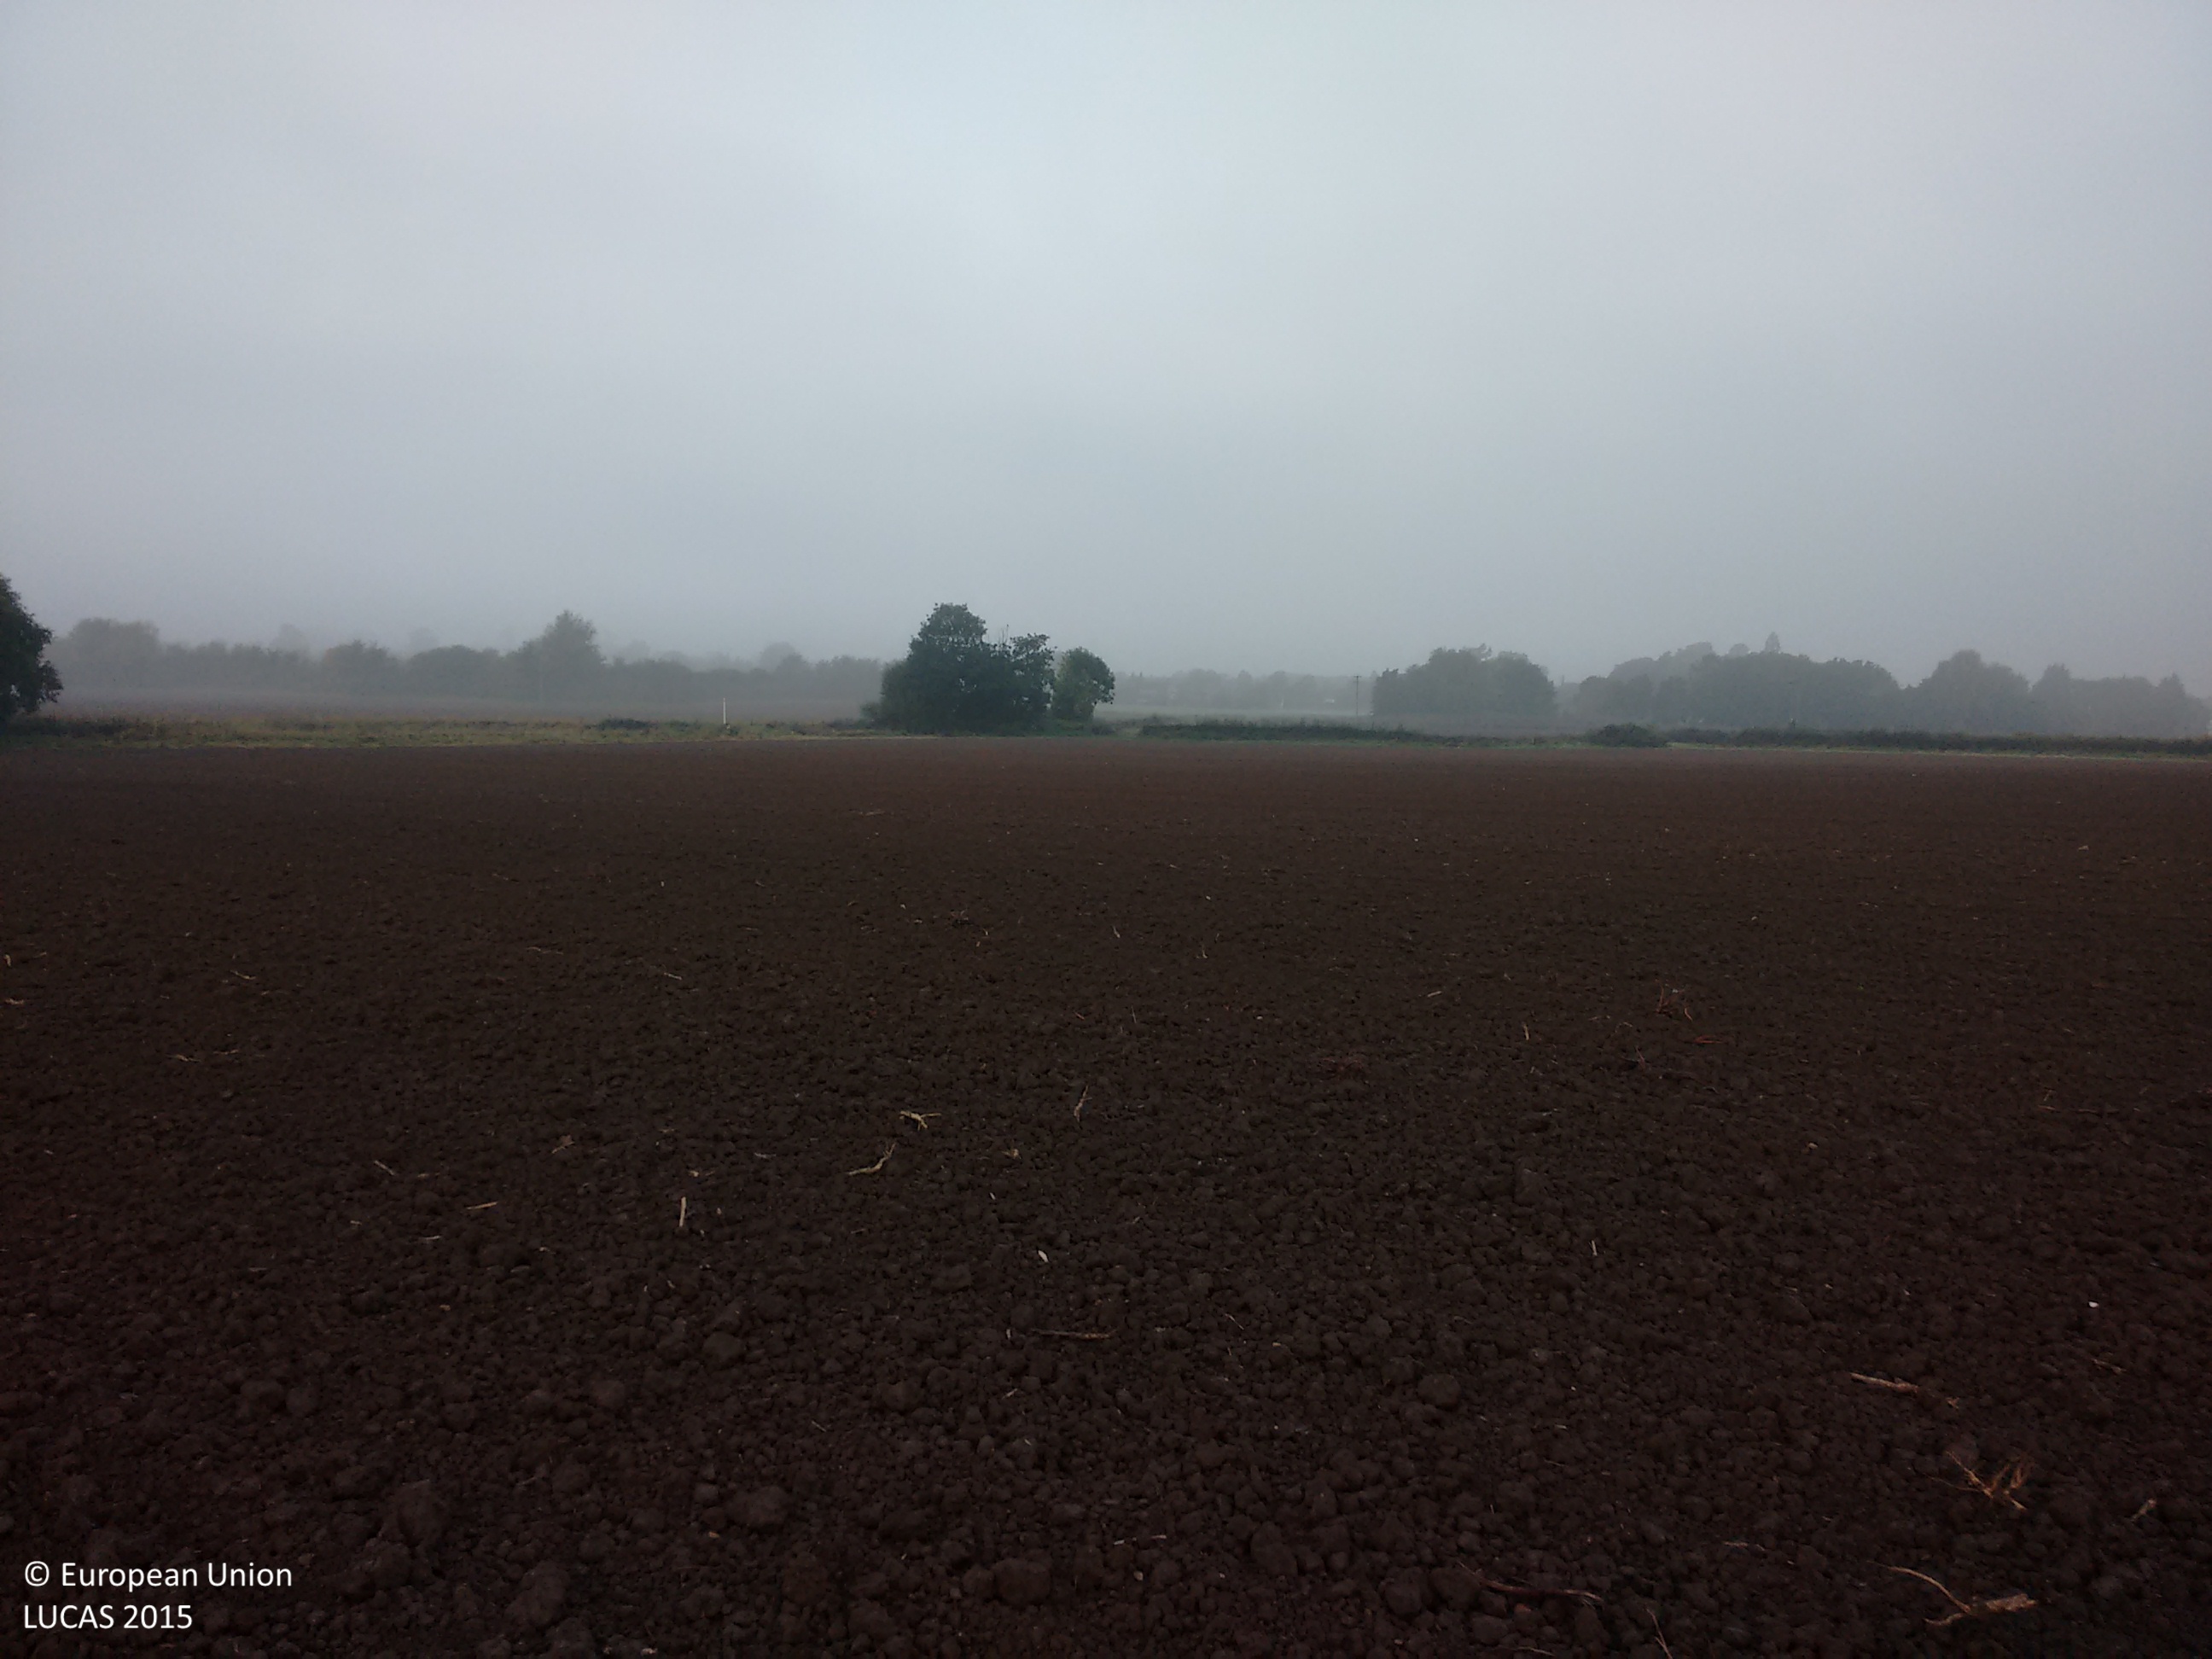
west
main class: Cropland
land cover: Common wheat
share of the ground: > 75 %
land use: Agriculture (excluding fallow land and kitchen gardens)
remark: Harvested field
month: October
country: GB
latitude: 51.7289
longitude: -2.3562
